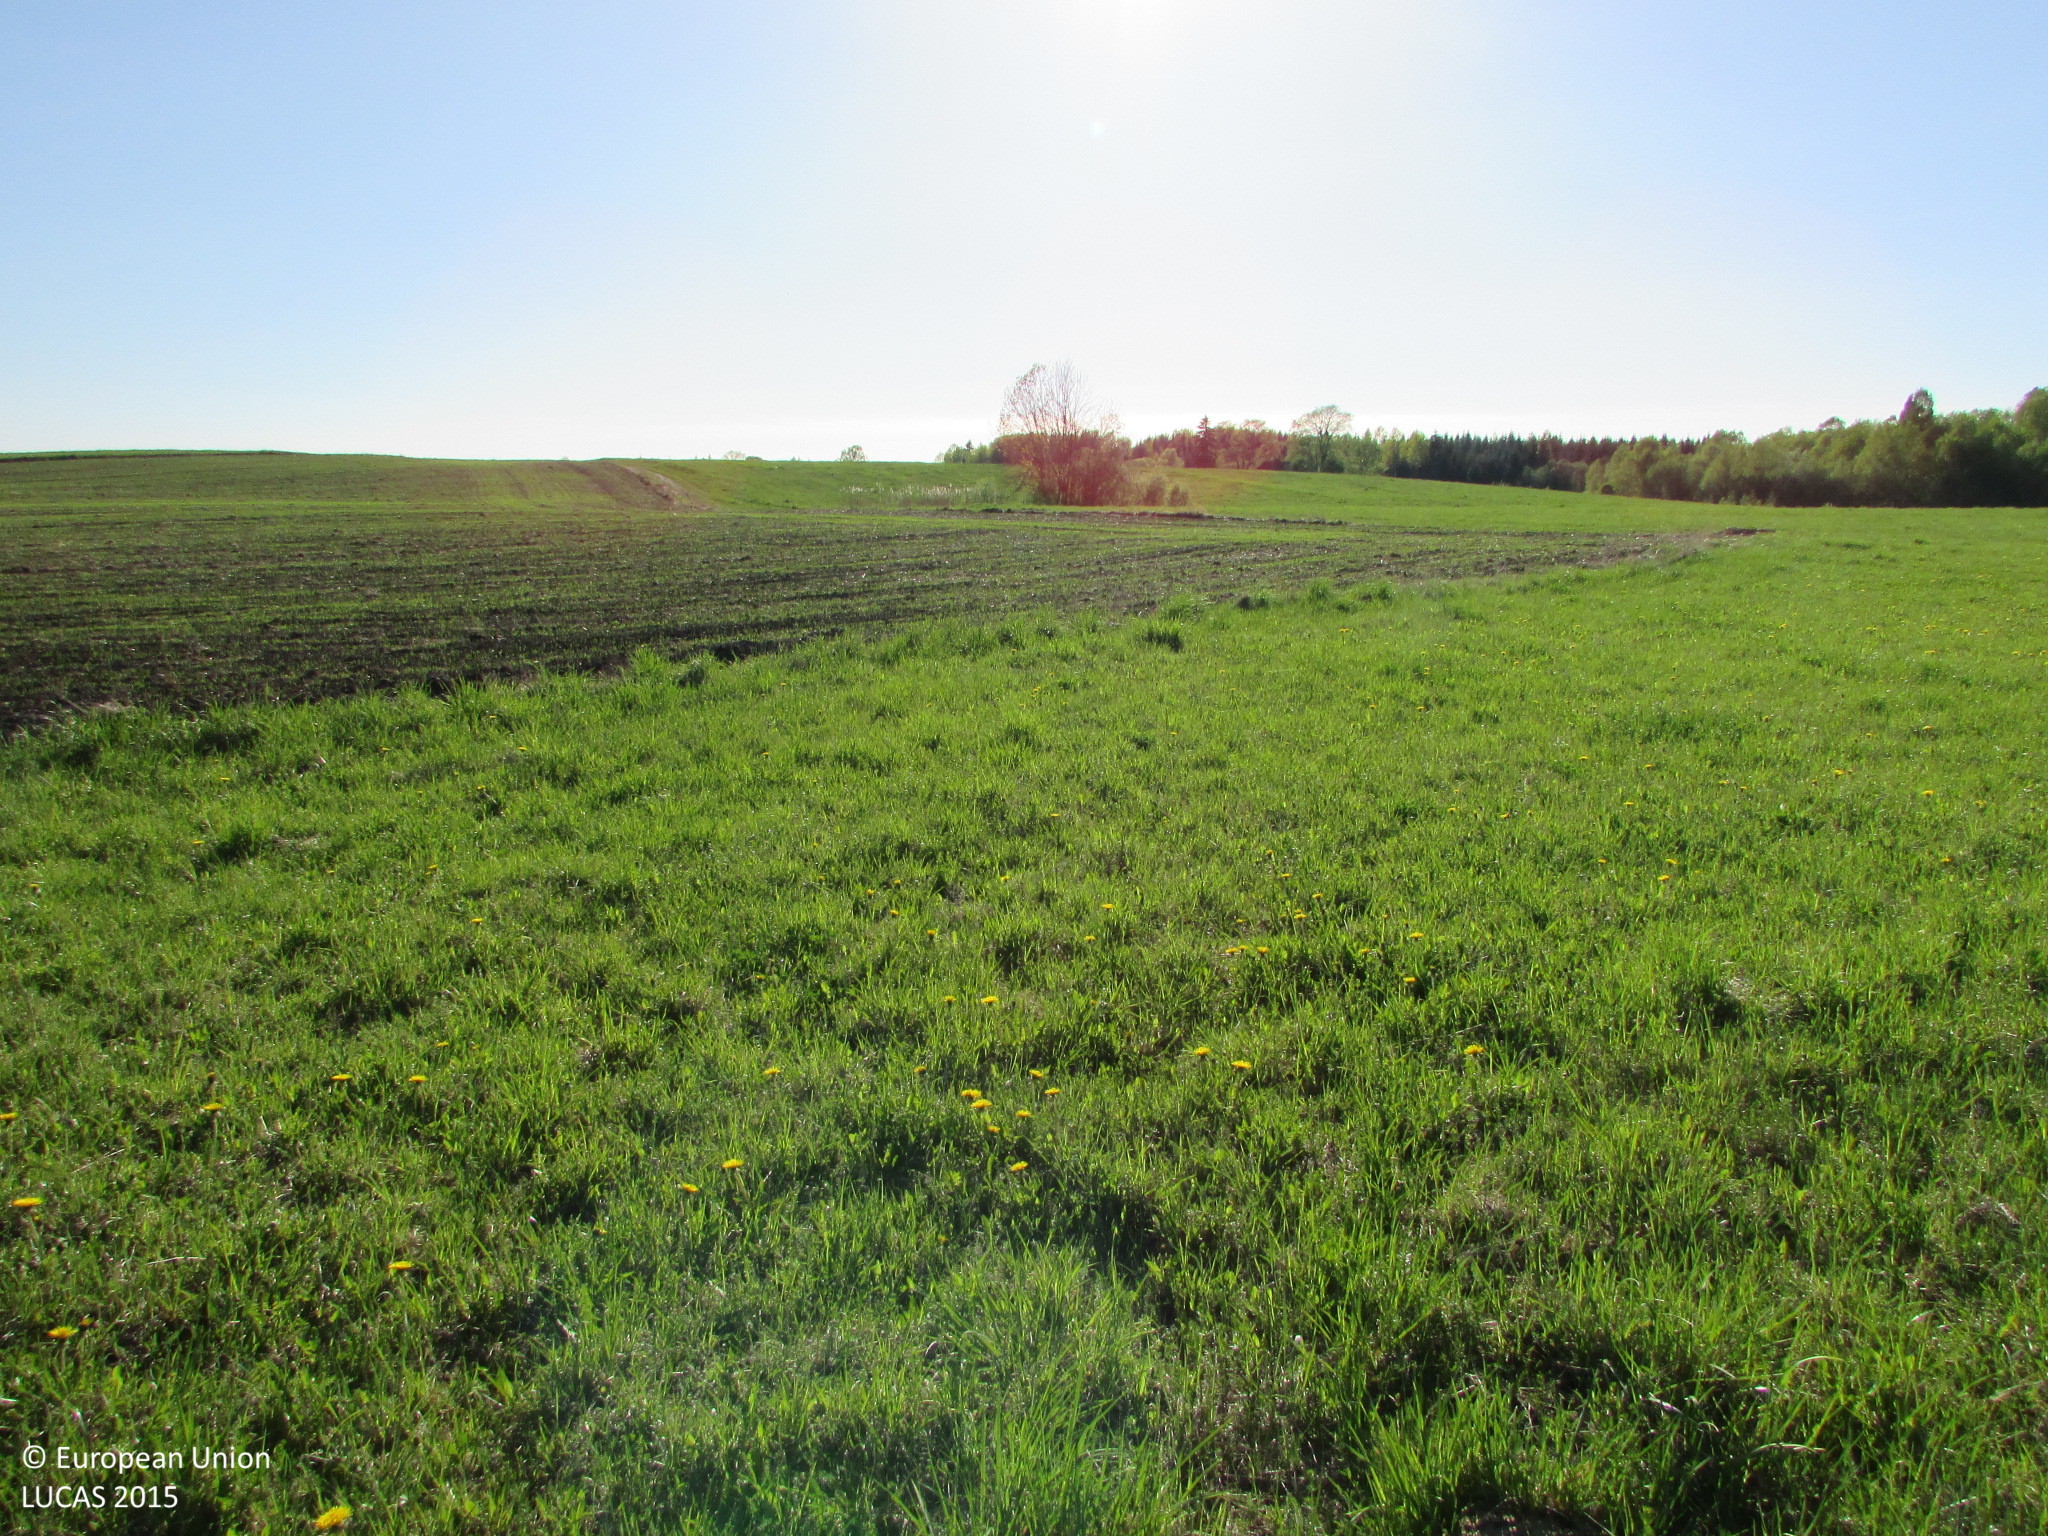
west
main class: Grassland
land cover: Grassland without tree/shrub cover
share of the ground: > 75 %
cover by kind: herbaceous plants 100 %
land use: Agriculture (excluding fallow land and kitchen gardens)
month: May
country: LV
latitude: 55.9019
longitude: 27.5701
